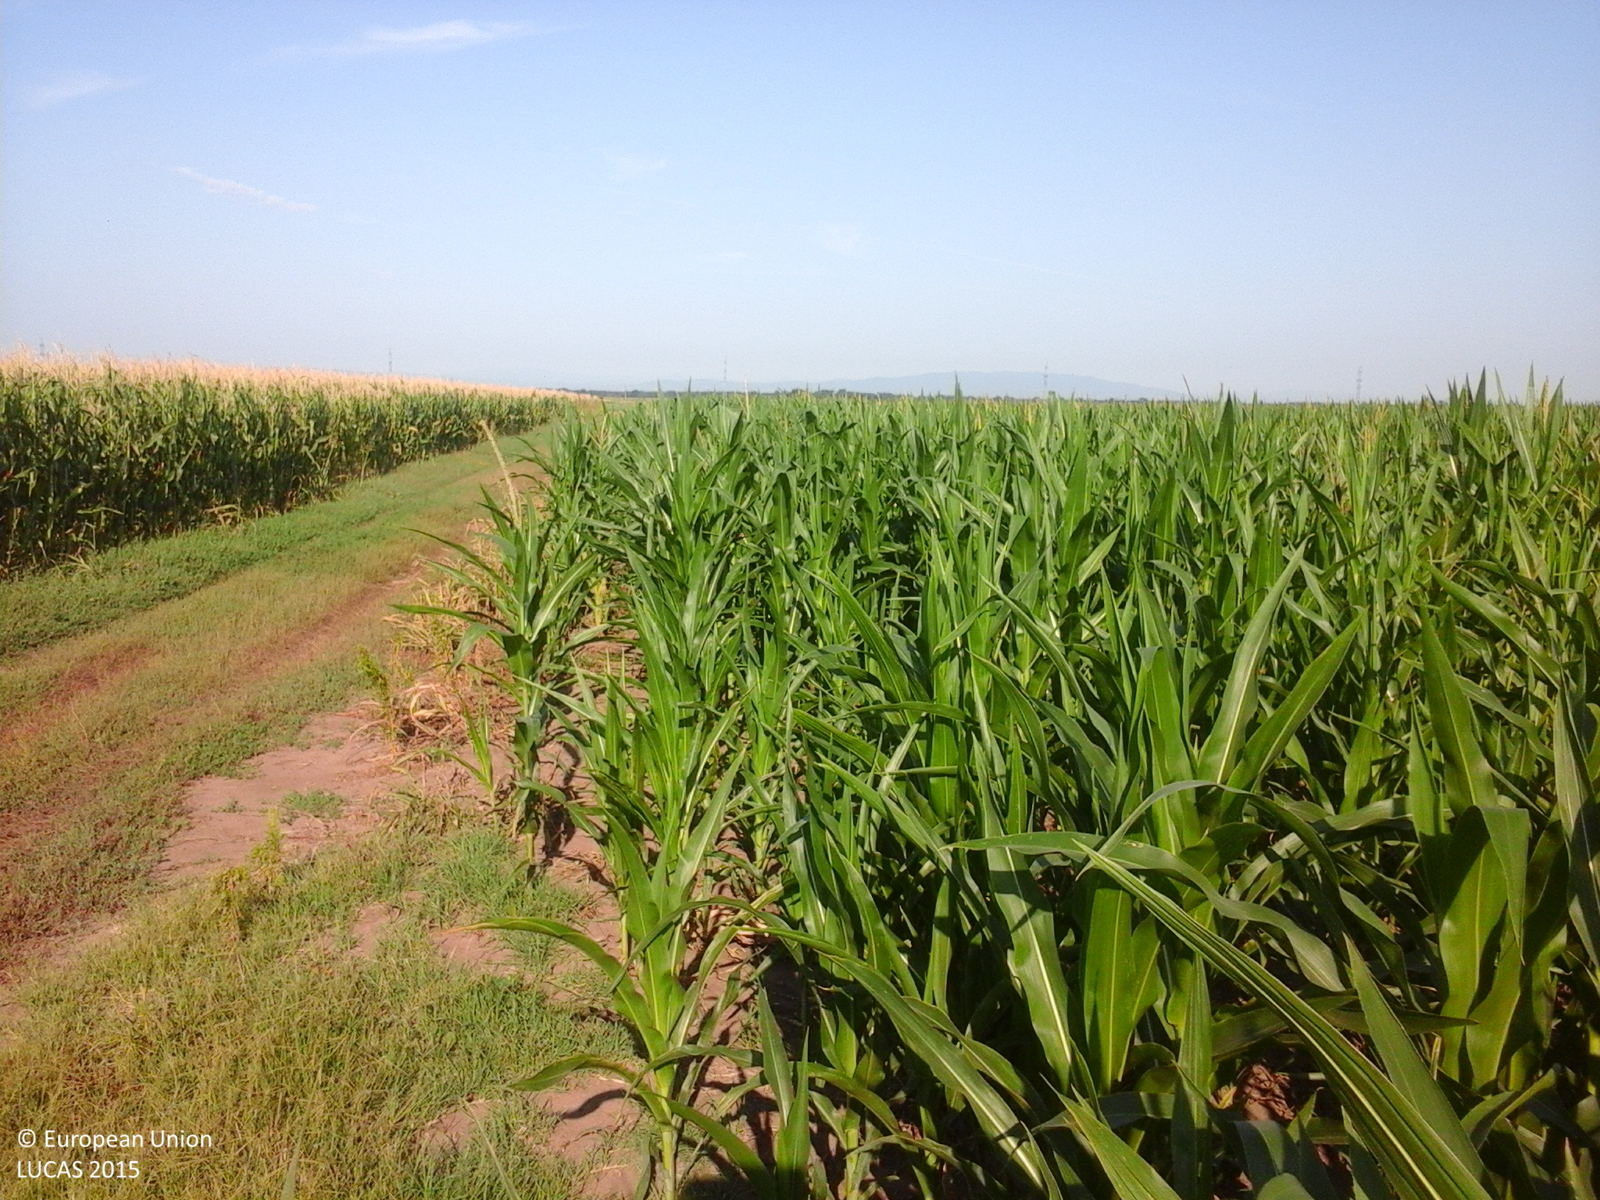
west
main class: Cropland
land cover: Maize
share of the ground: > 75 %
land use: Agriculture (excluding fallow land and kitchen gardens)
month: July
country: RO
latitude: 45.7937
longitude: 27.4051
